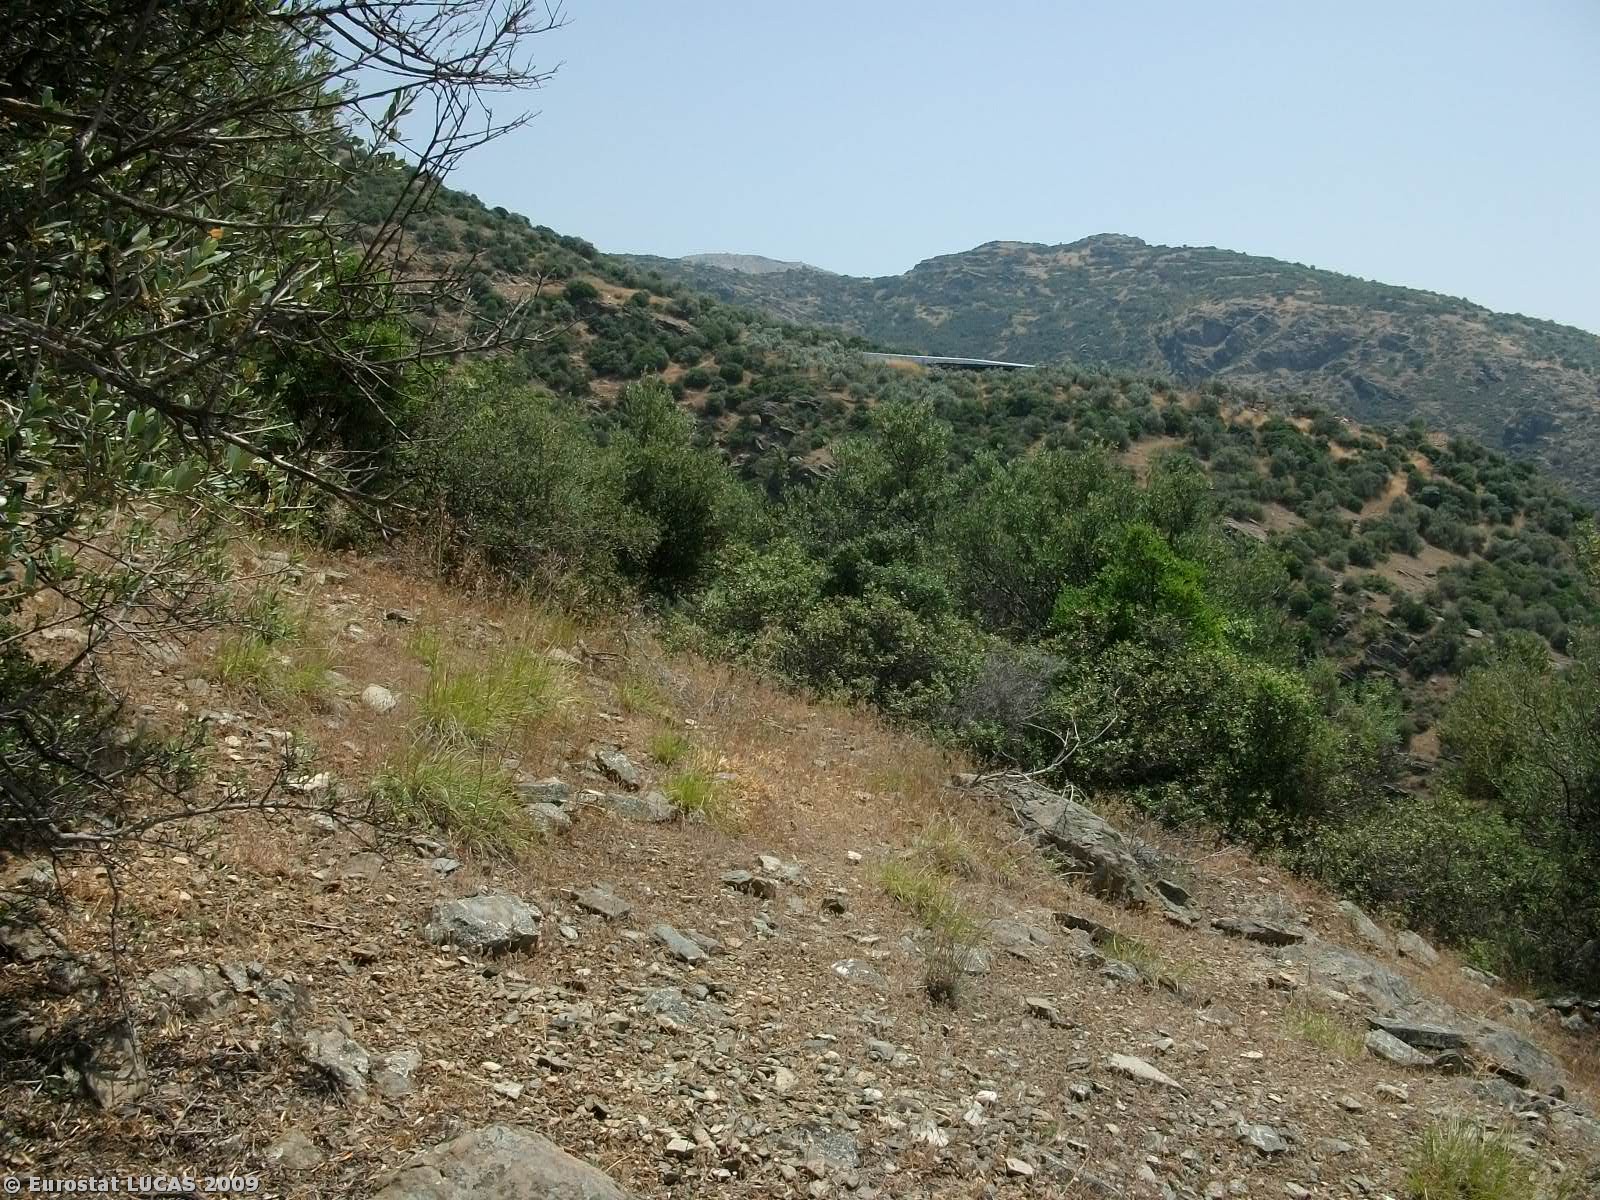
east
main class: Grassland
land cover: Grassland with sparse tree/shrub cover
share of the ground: 50 - 75 %
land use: Agriculture (excluding fallow land and kitchen gardens)
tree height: < 5 m
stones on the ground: 25 - 50 %
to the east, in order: Grassland with sparse tree/shrub cover; Shrubland without tree cover; Rivers and streams; Shrubland with sparse tree cover; Rivers and streams; Shrubland without tree cover
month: June
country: GR
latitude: 39.8056
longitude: 22.5493
